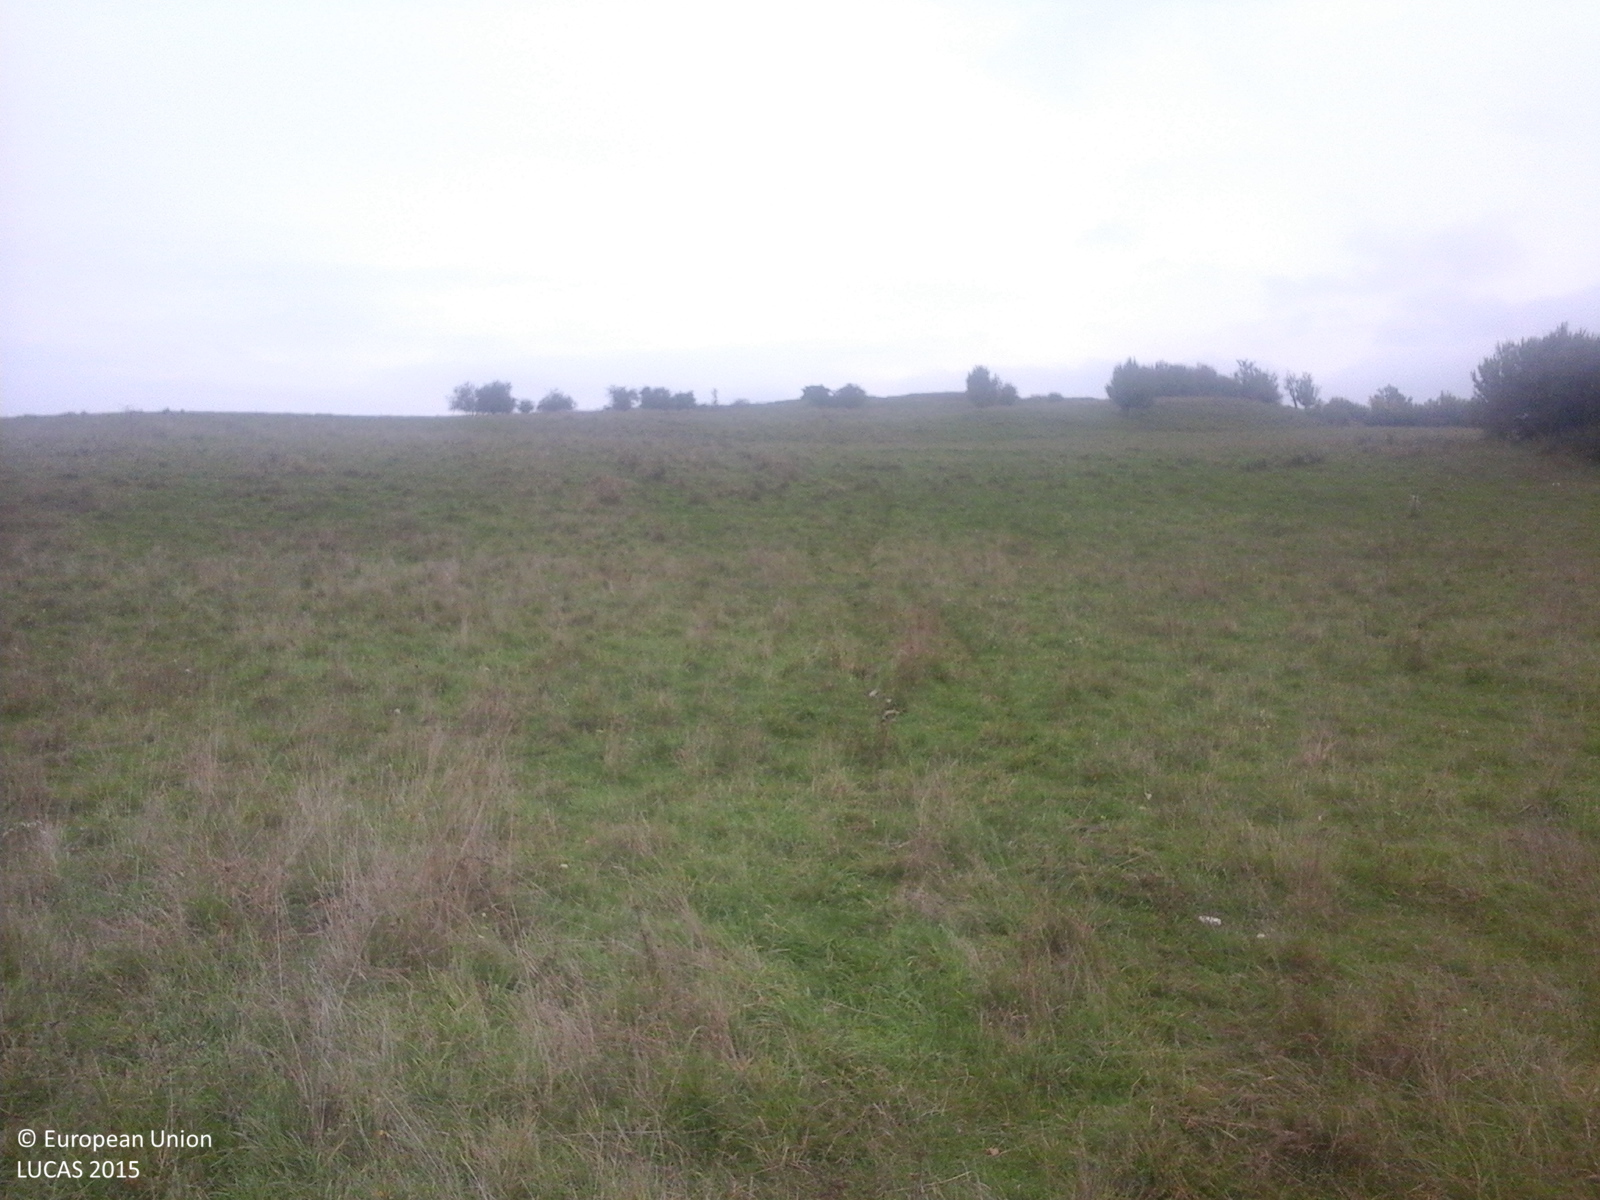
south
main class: Grassland
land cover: Grassland without tree/shrub cover
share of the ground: > 75 %
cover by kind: herbaceous plants 100 %
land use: Agriculture (excluding fallow land and kitchen gardens)
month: October
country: RO
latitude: 46.2317
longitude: 24.9145
